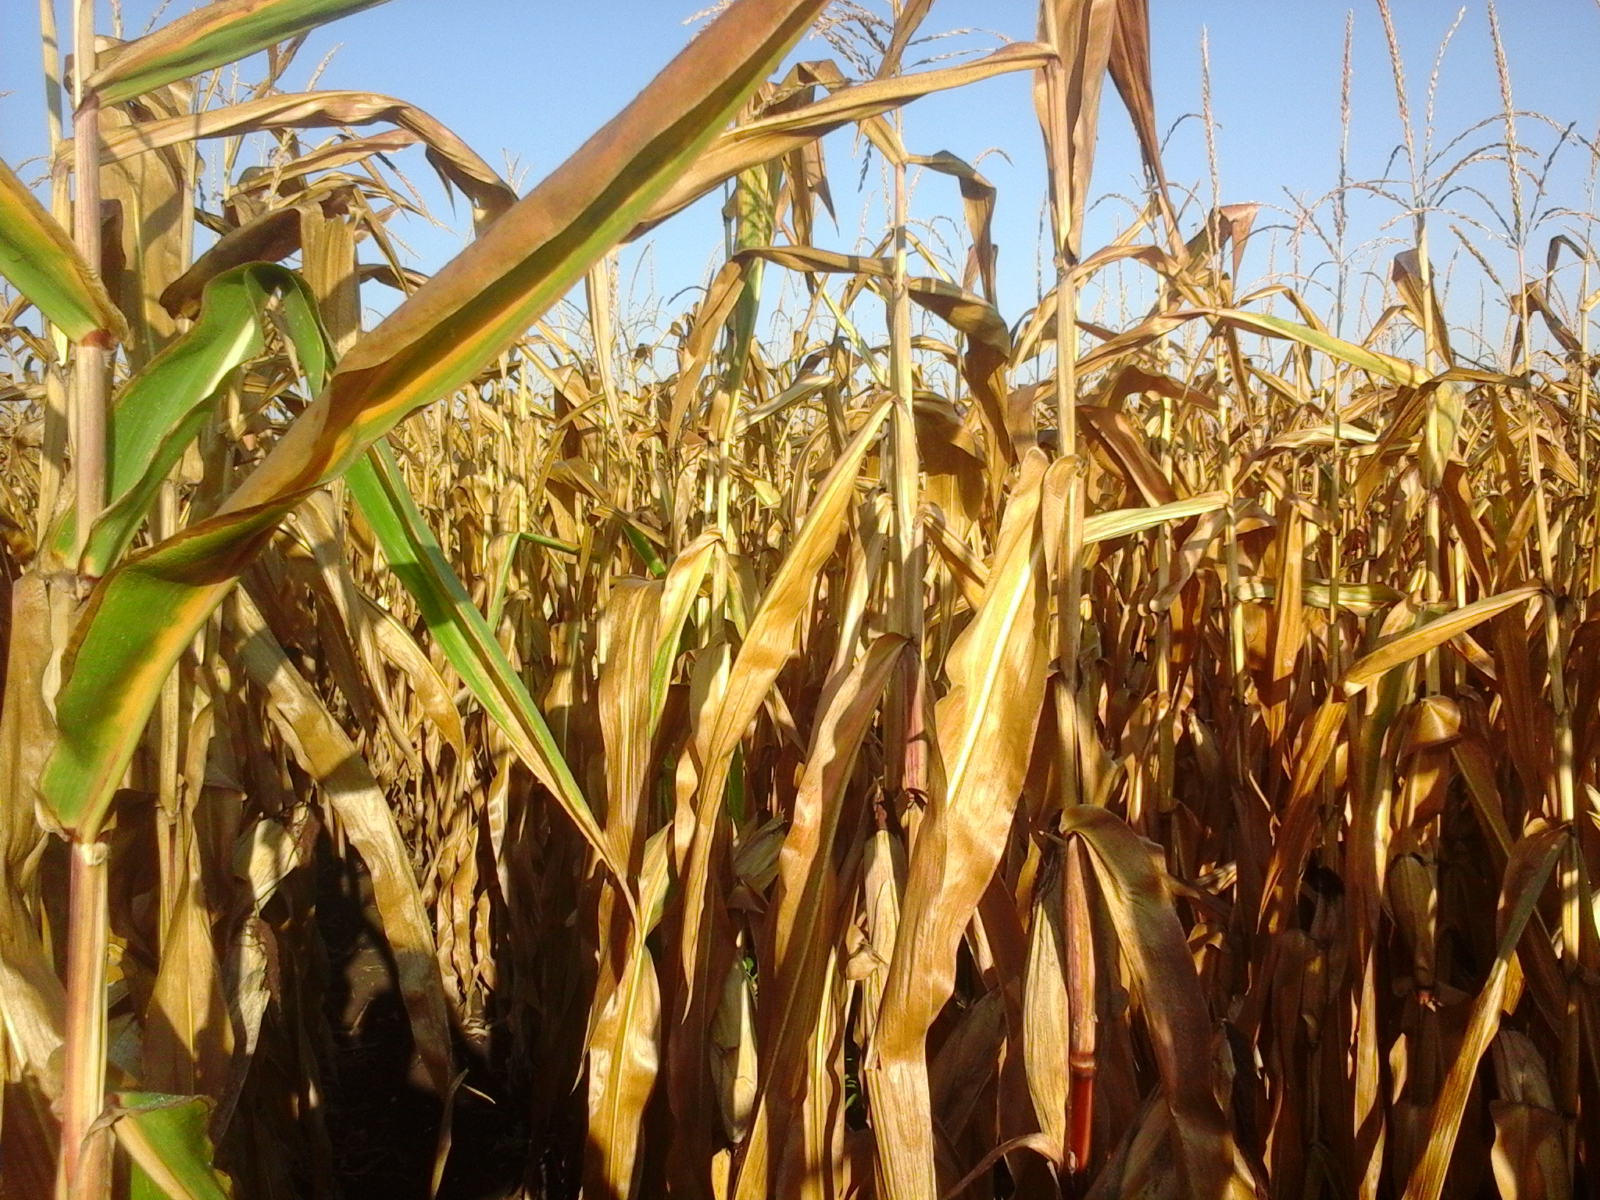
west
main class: Cropland
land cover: Maize
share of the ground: > 75 %
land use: Agriculture (excluding fallow land and kitchen gardens)
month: August
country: RO
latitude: 45.9805
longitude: 21.0140
